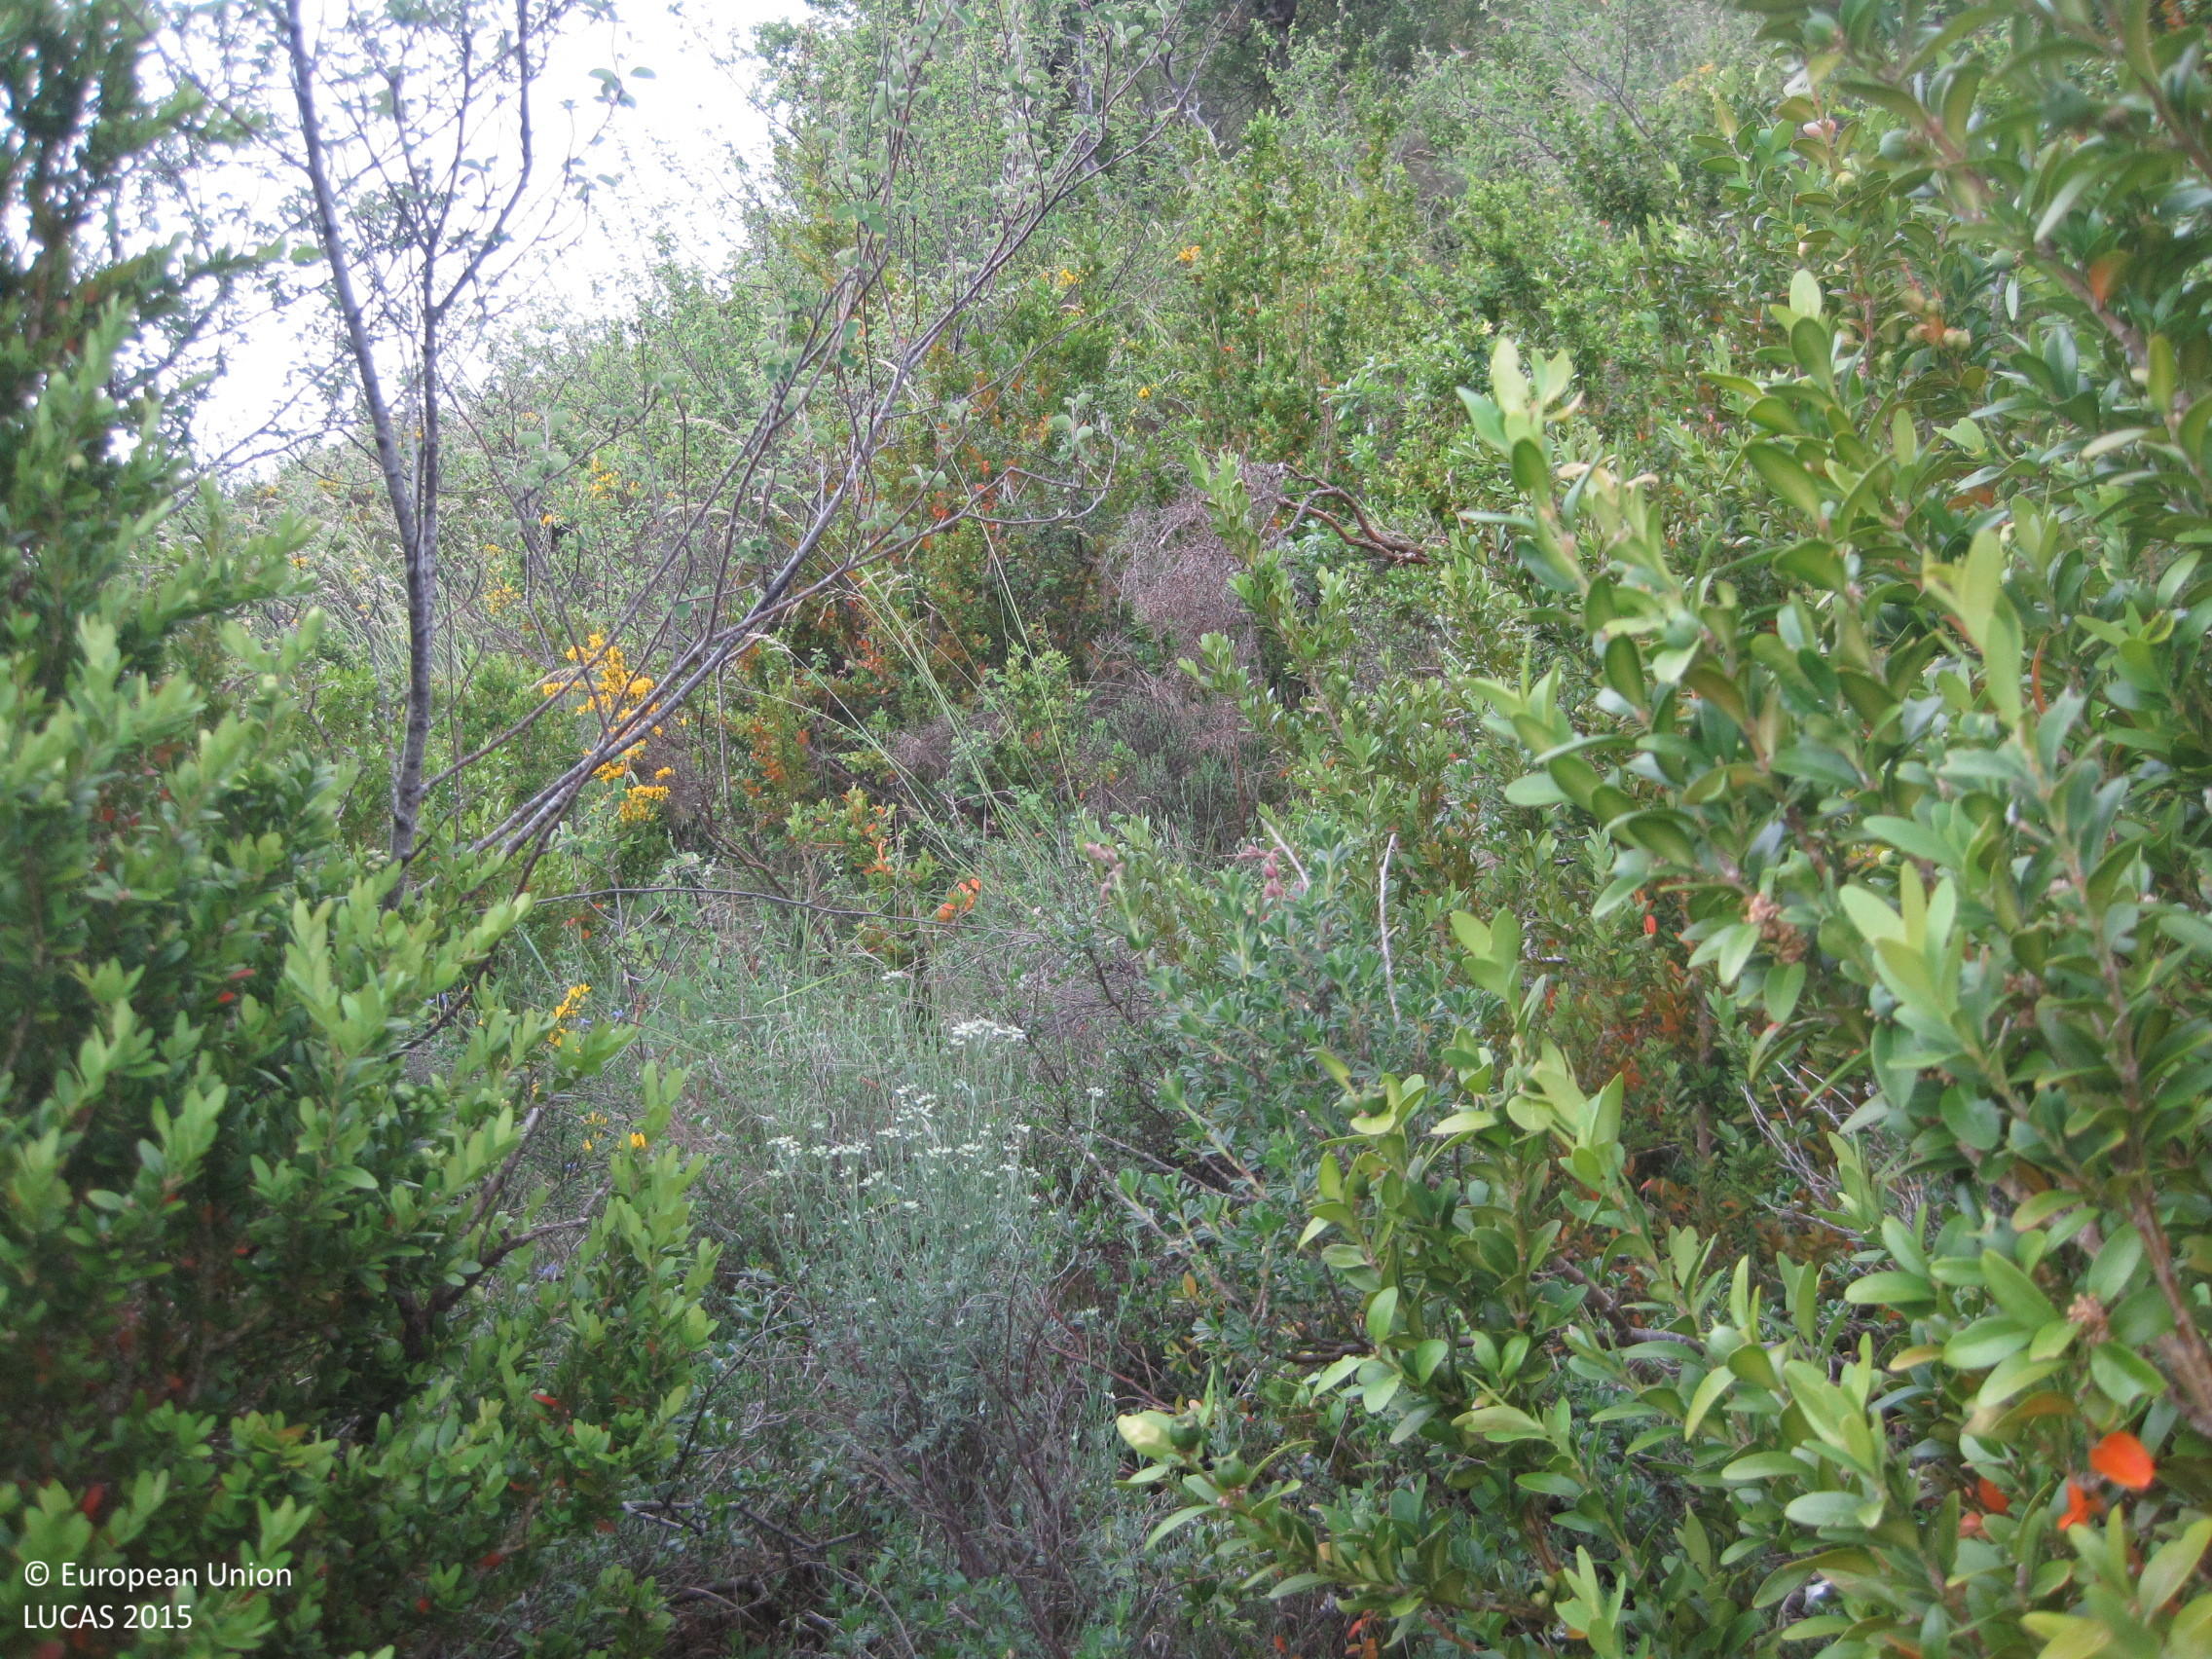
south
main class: Shrubland
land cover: Shrubland without tree cover
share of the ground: > 75 %
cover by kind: shrubs 95 %, herbaceous plants 5 %
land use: Semi-natural and natural areas not in use
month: May
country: ES
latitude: 42.5880
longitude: -1.4285
